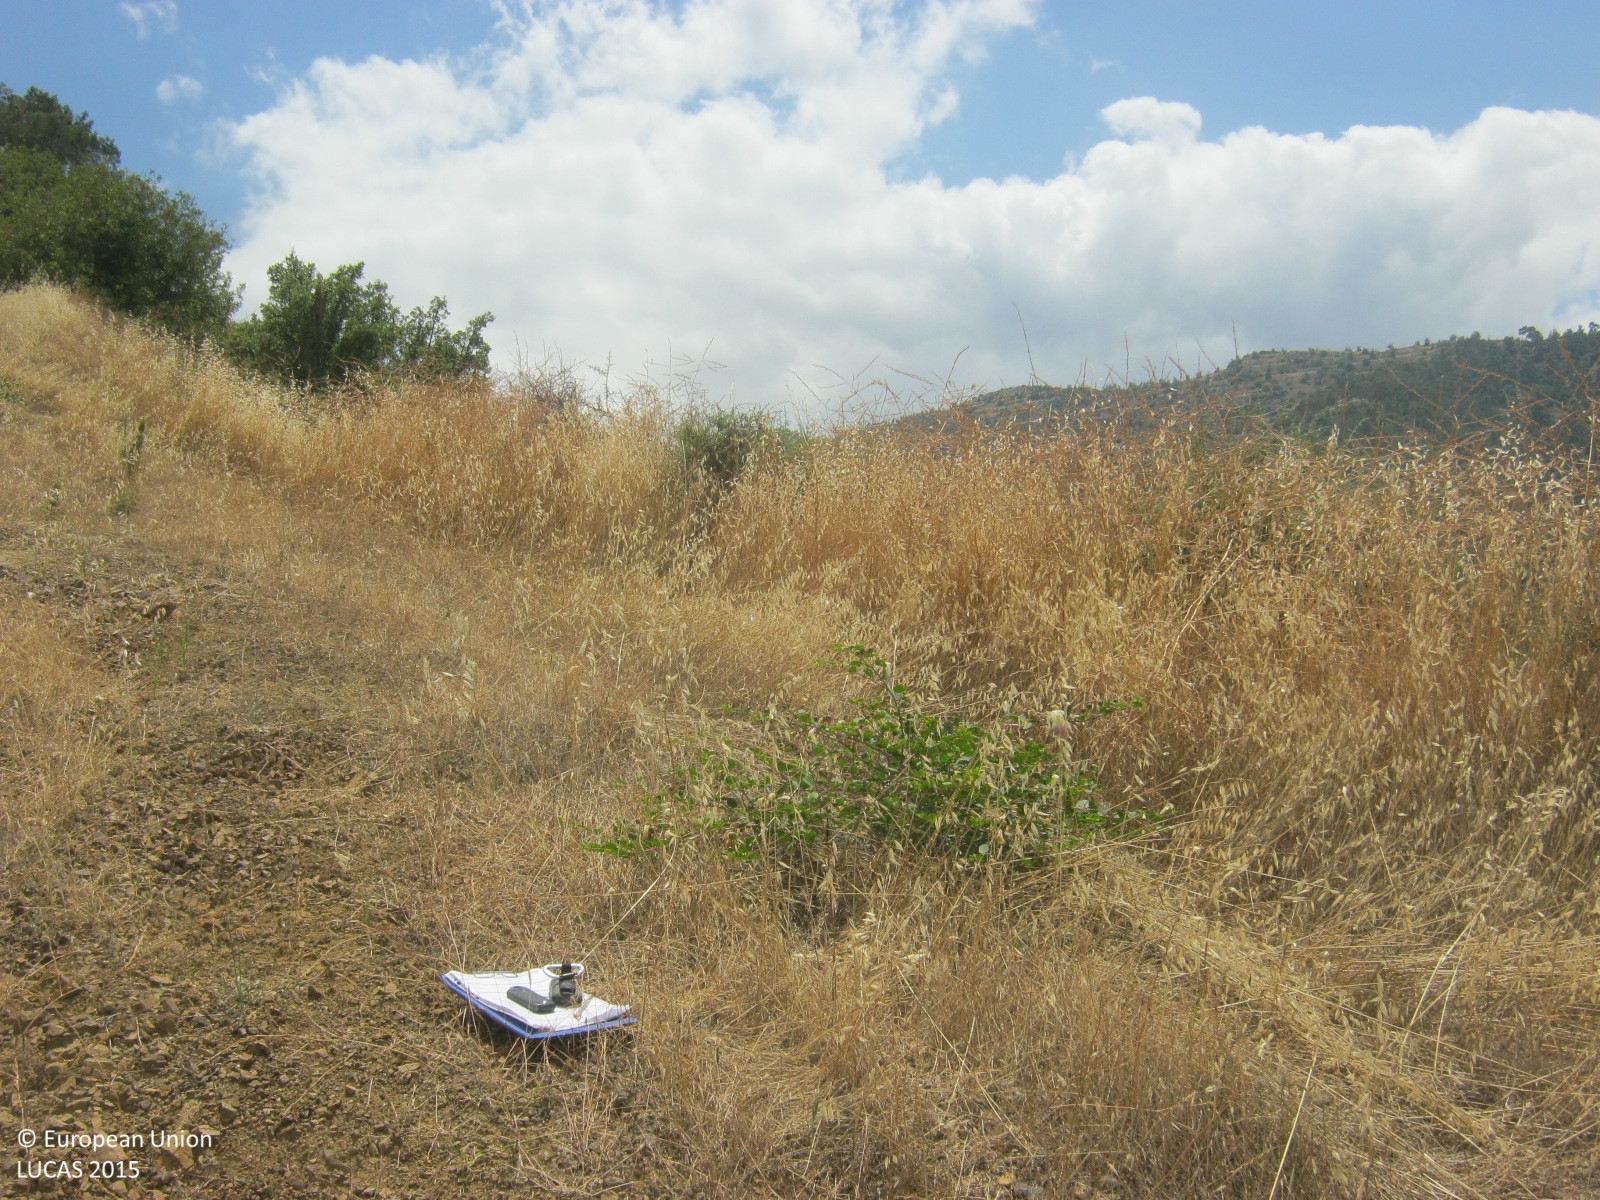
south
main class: Shrubland
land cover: Shrubland without tree cover
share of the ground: 25 - 50 %
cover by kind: herbaceous plants 50 %, shrubs 40 %, unconsolidated bare surface 10 %
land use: Semi-natural and natural areas not in use
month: June
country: CY
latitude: 35.0332
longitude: 32.8706
